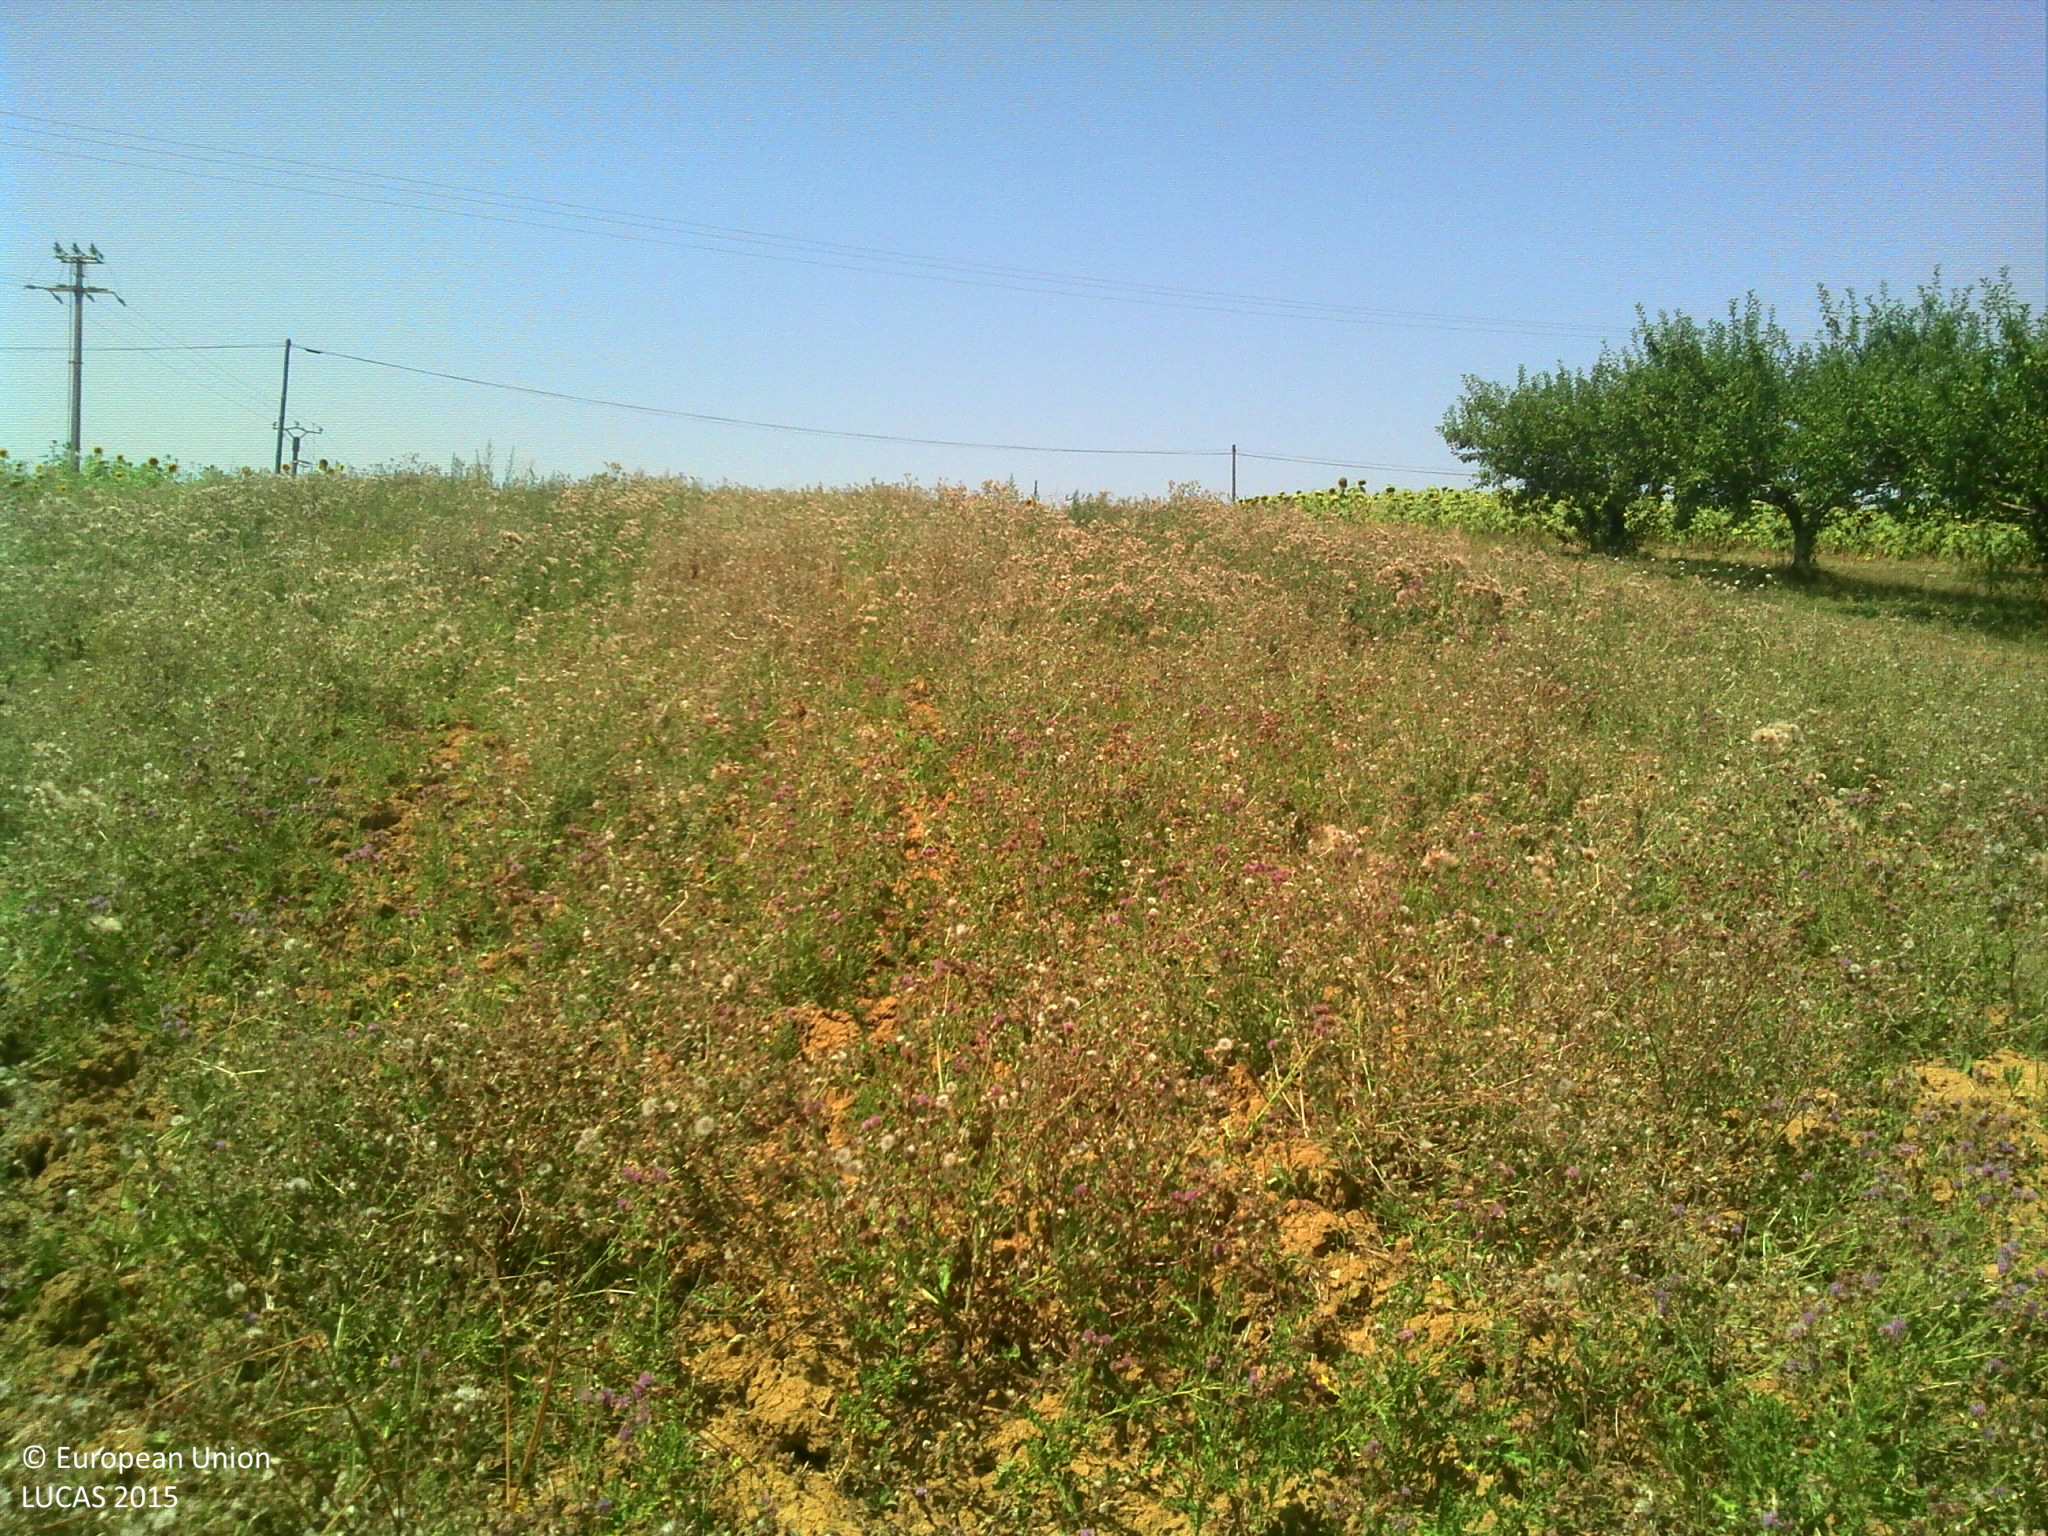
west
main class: Grassland
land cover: Spontaneously vegetated surfaces
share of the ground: > 75 %
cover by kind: herbaceous plants 100 %
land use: Agriculture (excluding fallow land and kitchen gardens)
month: August
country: FR
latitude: 44.2203
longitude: 1.2991
